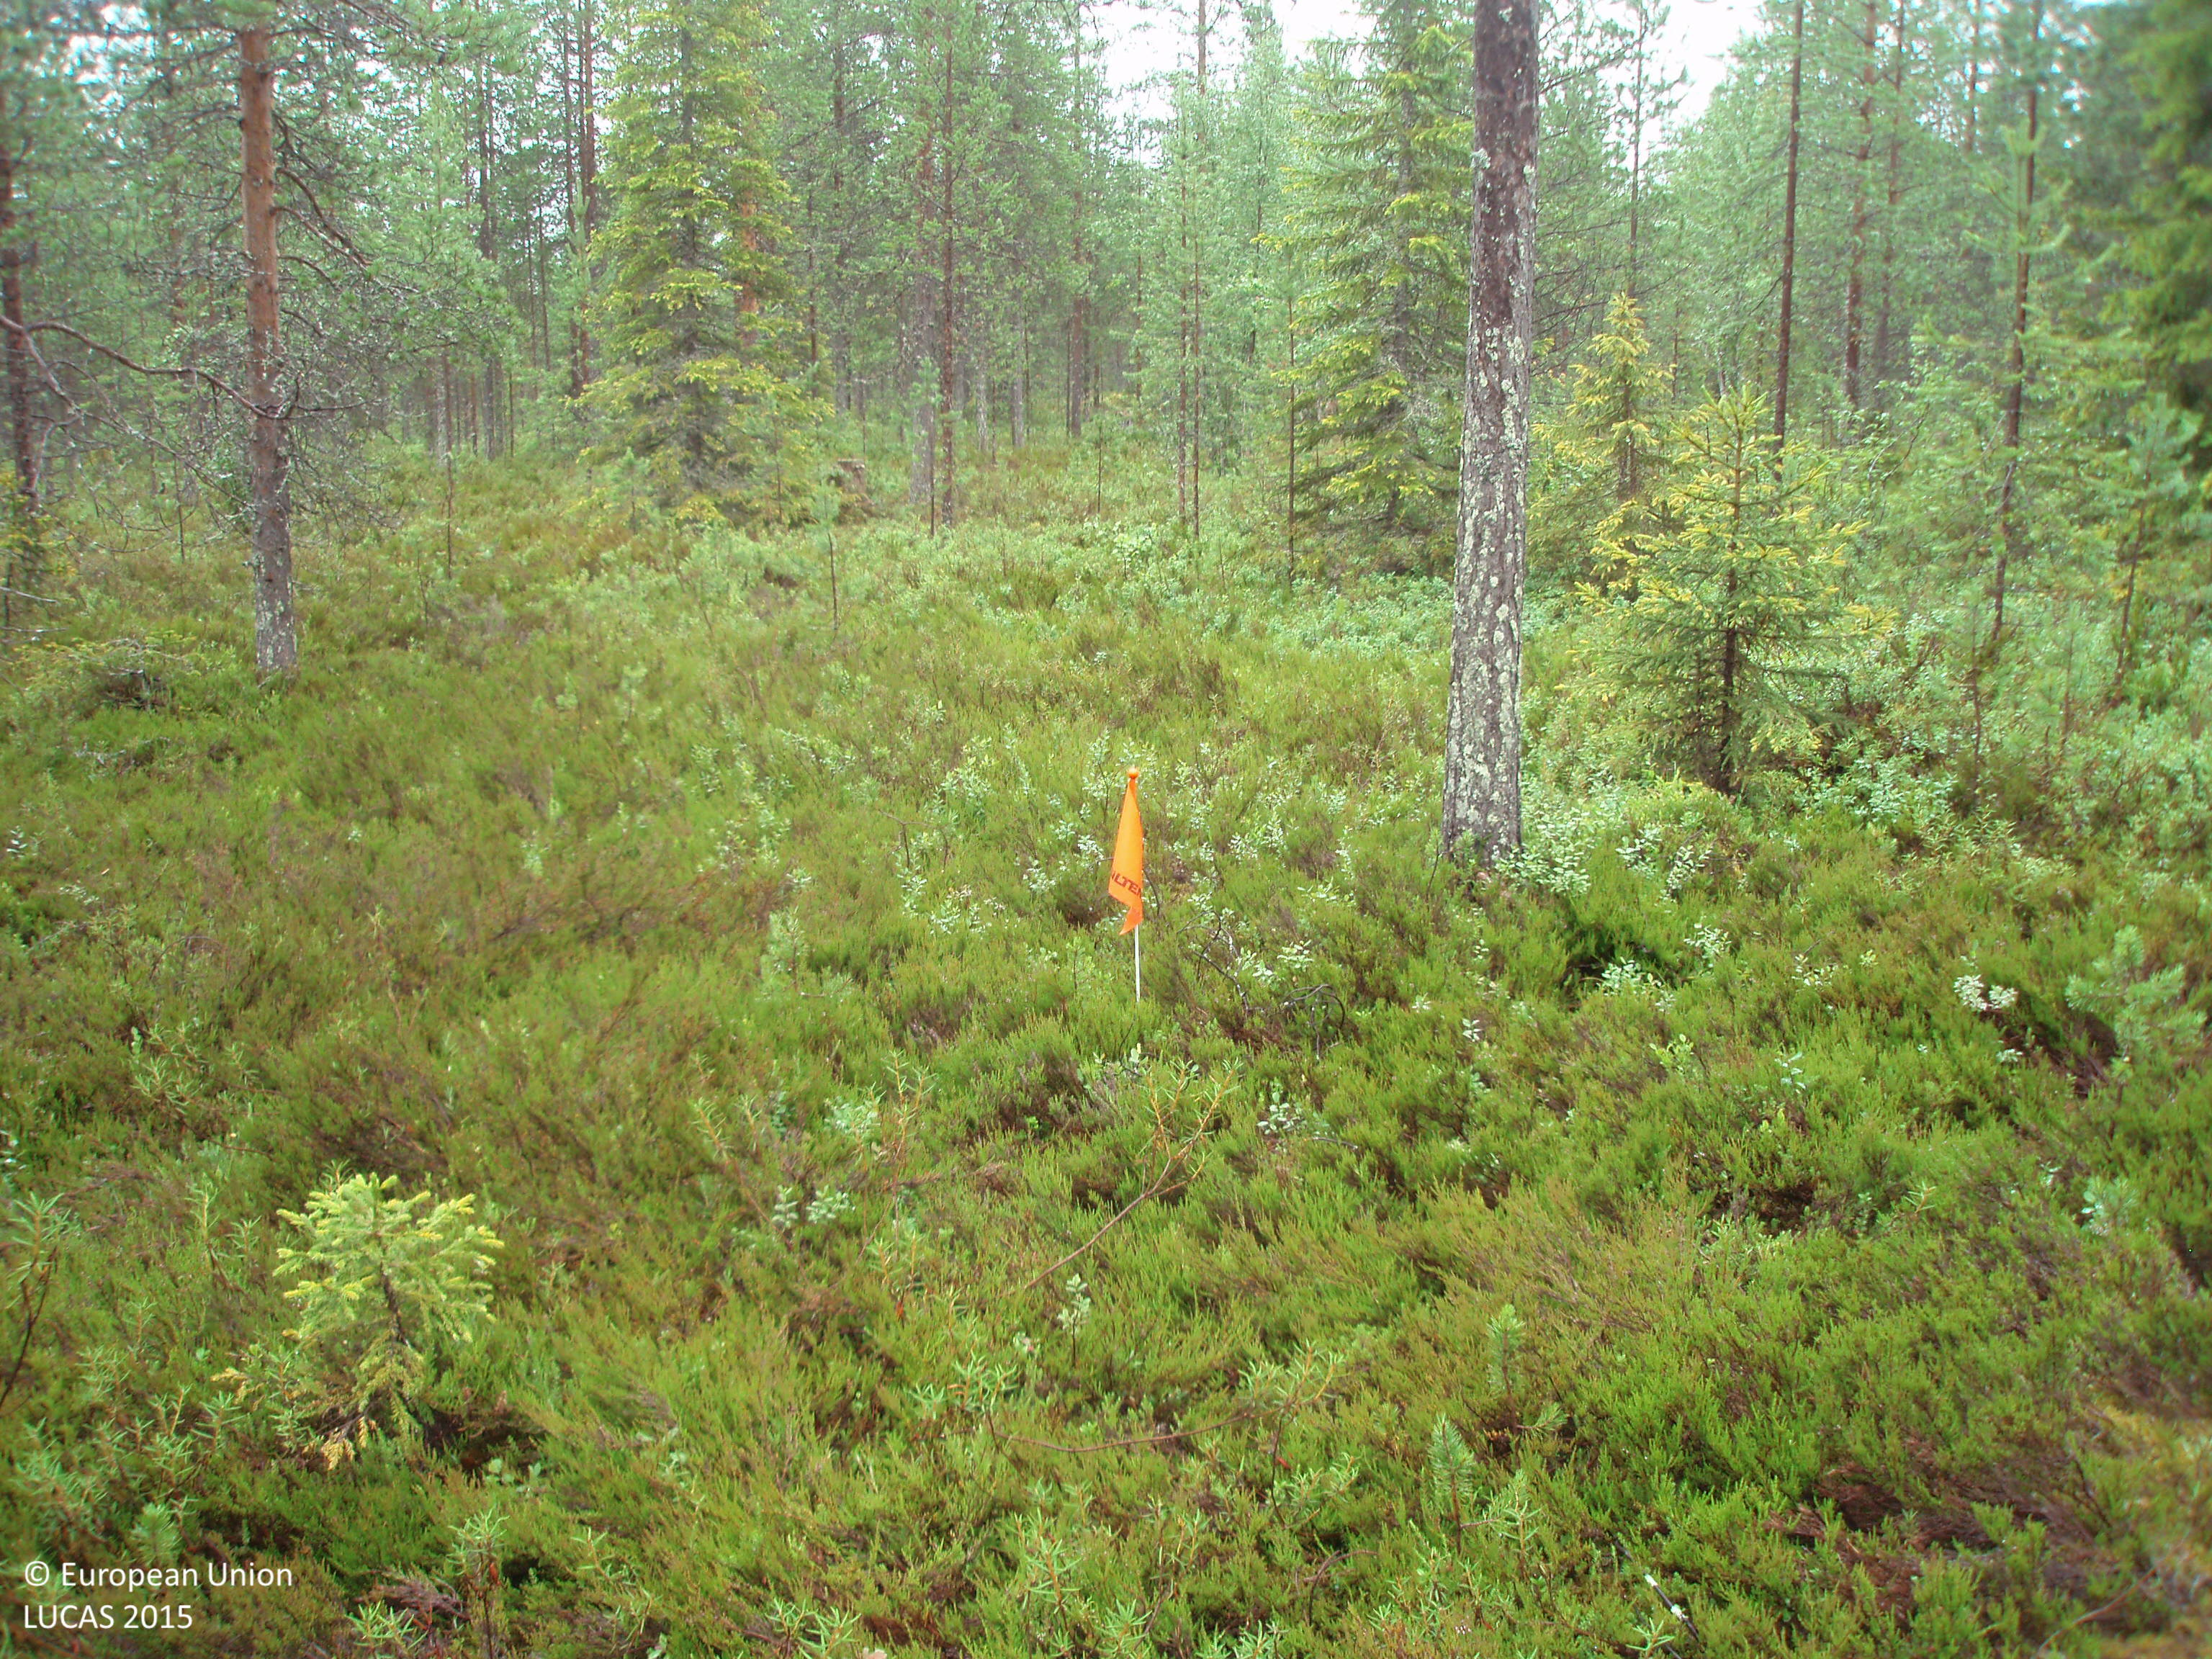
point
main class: Woodland
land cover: Pine dominated coniferous woodland
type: boreal forest
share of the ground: 25 - 50 %
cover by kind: shrubs 60 %, coniferous forest trees 40 %
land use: Forestry
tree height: > 5 m
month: August
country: FI
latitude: 65.5795
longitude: 27.4466
